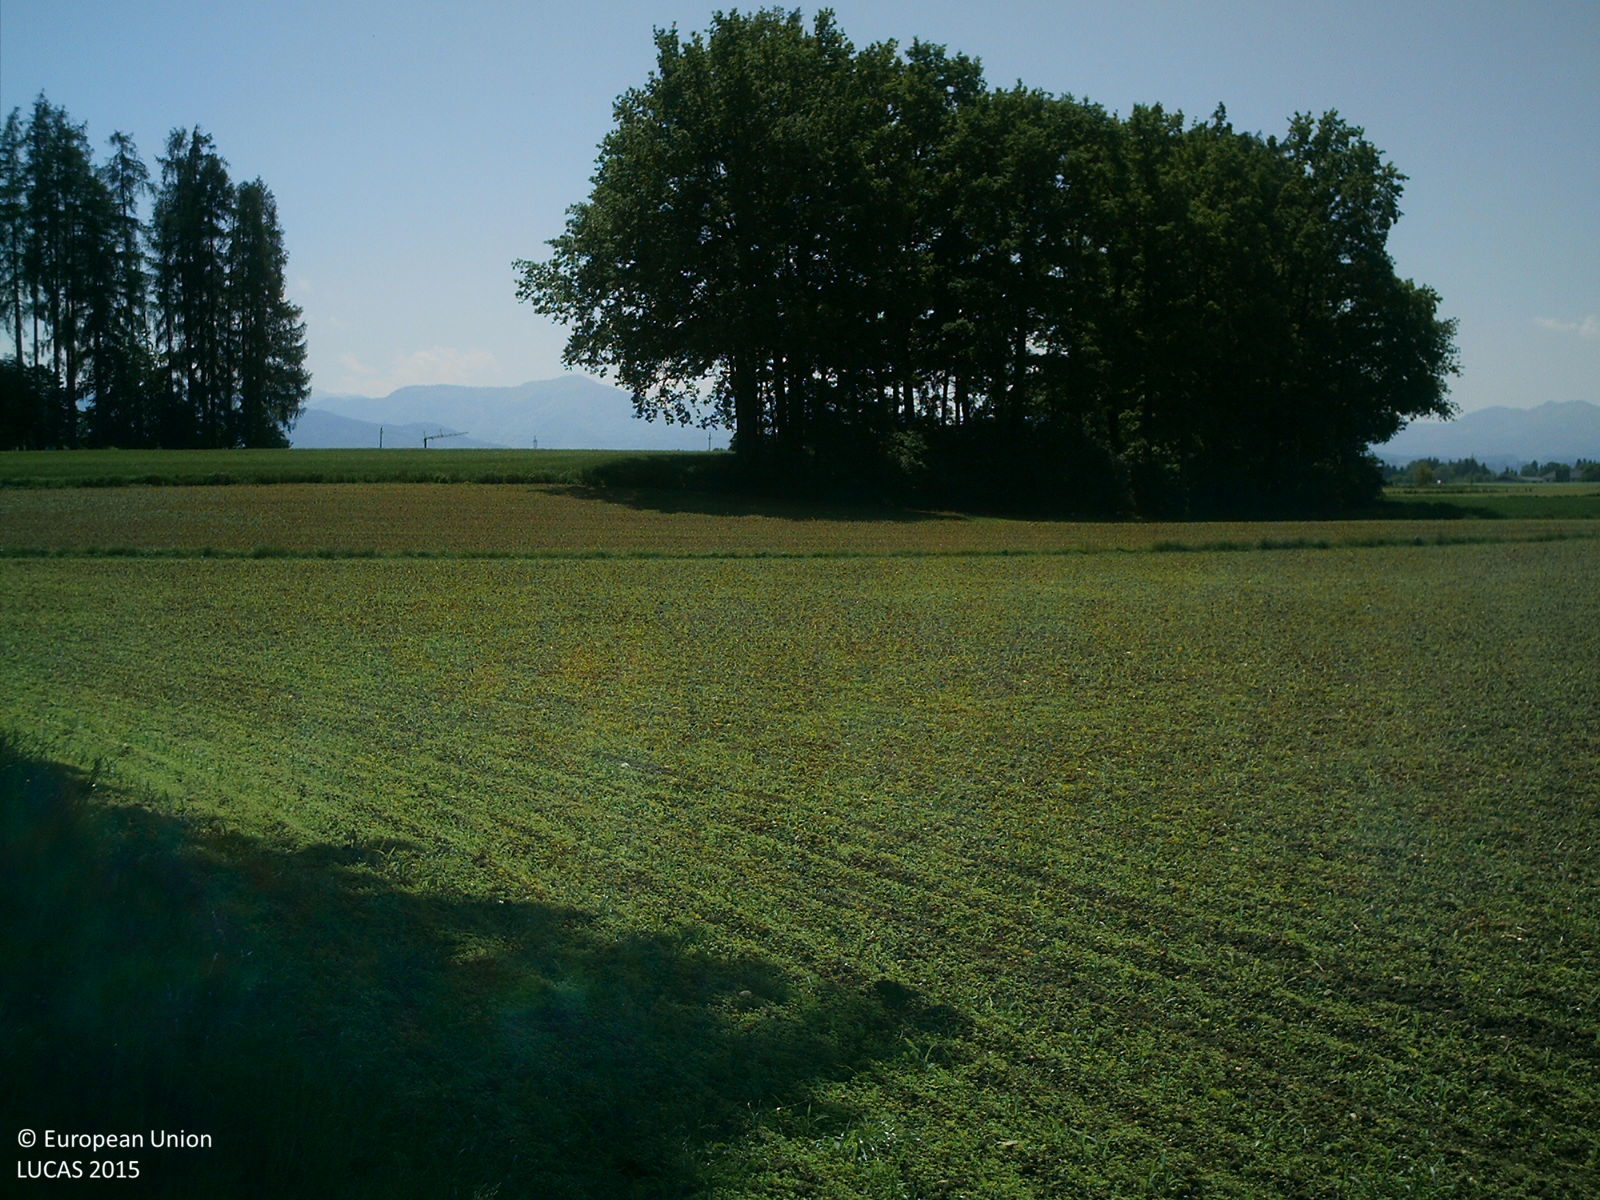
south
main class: Cropland
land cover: Maize
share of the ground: < 10 %
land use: Agriculture (excluding fallow land and kitchen gardens)
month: May
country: AT
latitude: 48.0246
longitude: 14.0087
